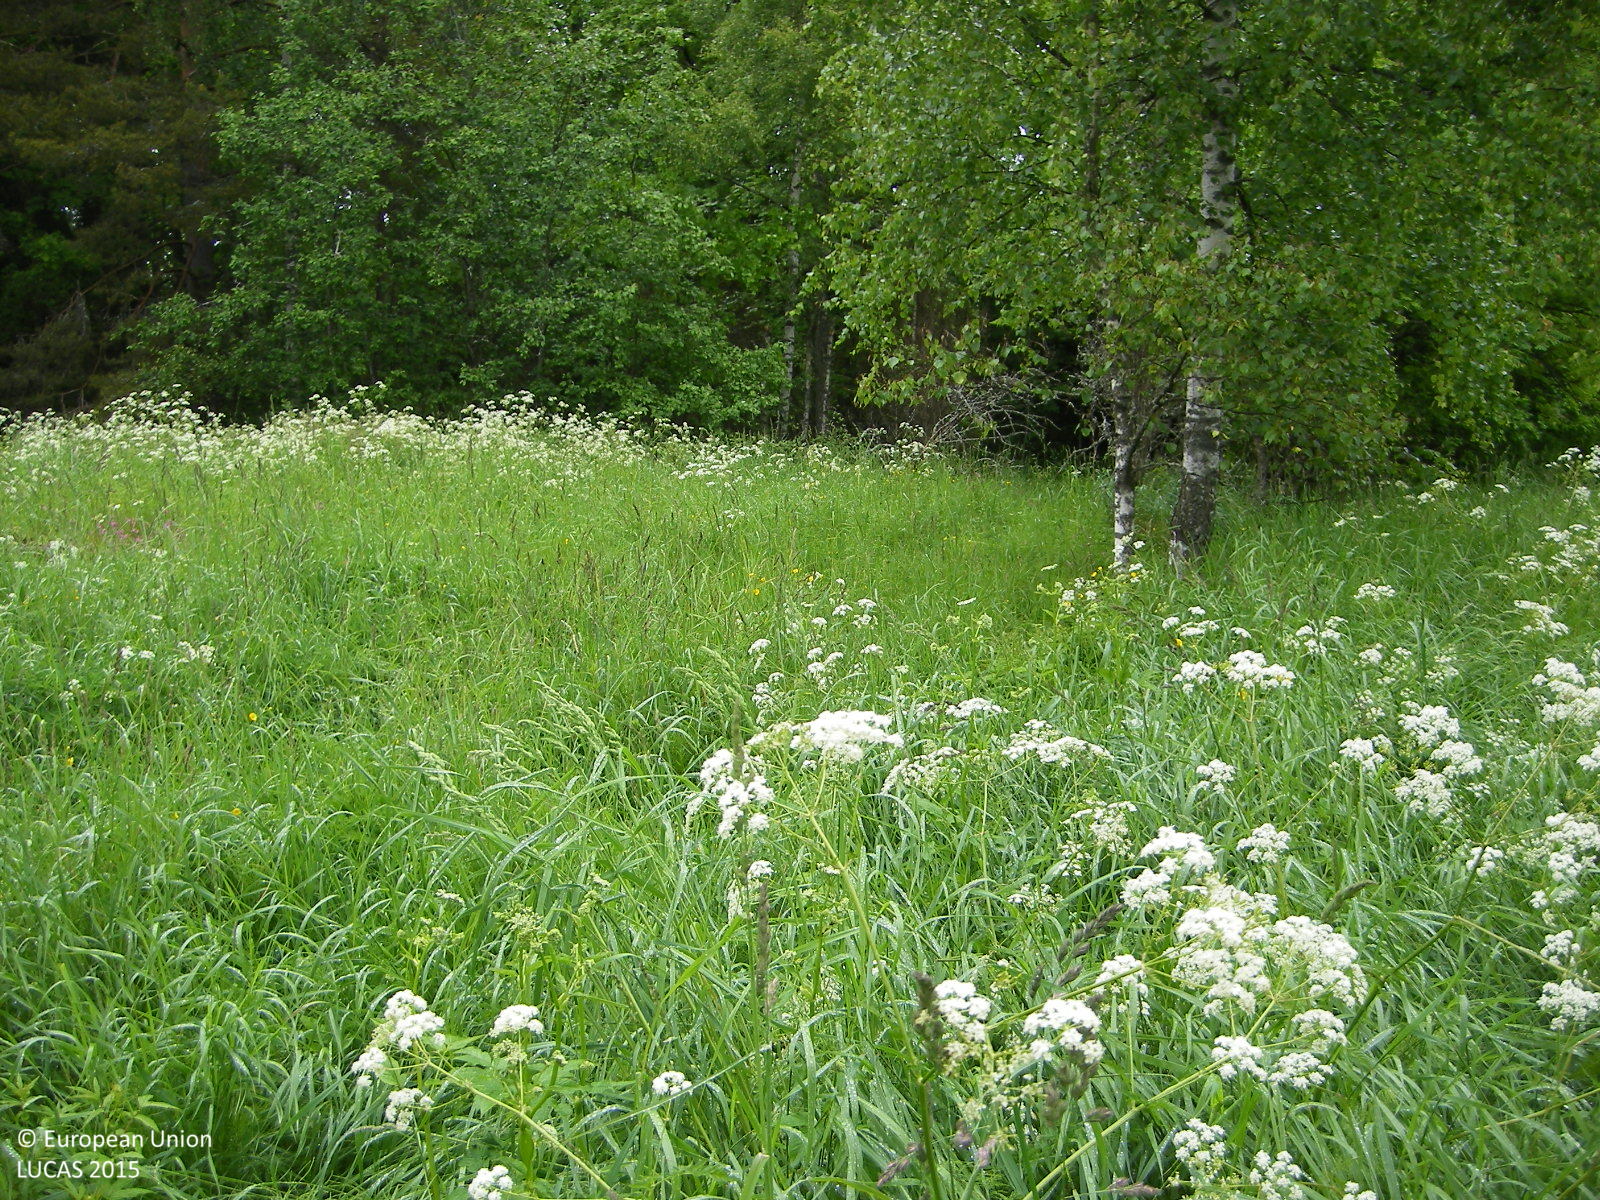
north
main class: Grassland
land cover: Spontaneously vegetated surfaces
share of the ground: > 75 %
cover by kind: herbaceous plants 100 %
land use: Fallow land
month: June
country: FI
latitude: 60.2237
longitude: 23.8693
